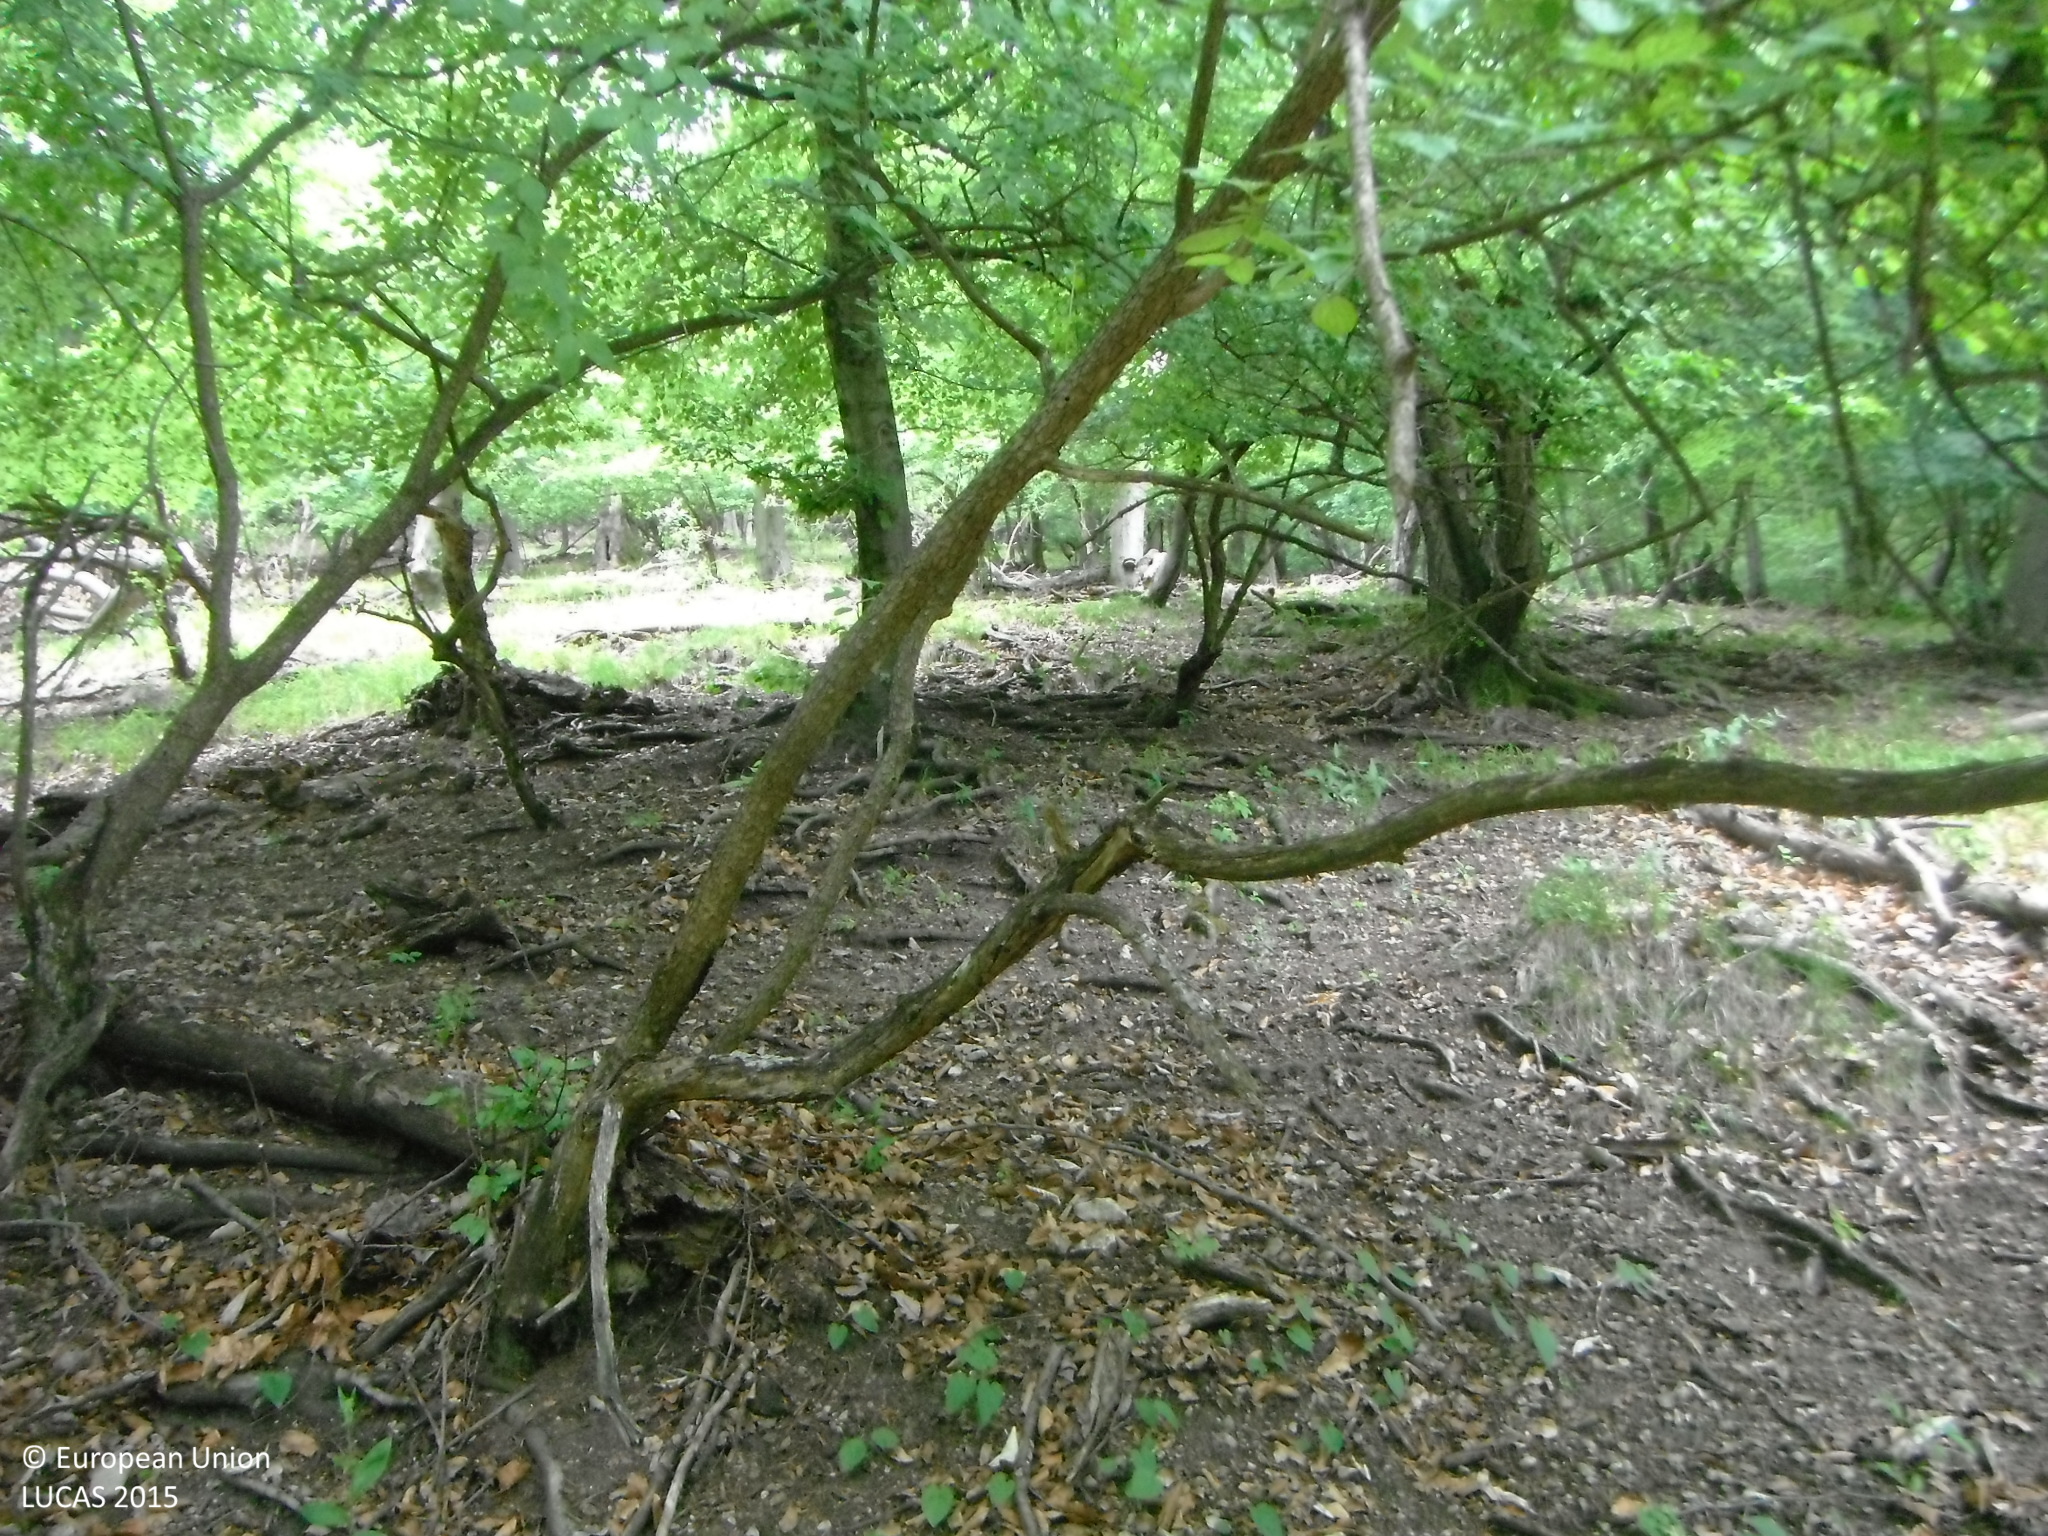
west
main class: Woodland
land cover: Broadleaved woodland
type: beech forest
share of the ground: > 75 %
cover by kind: broadleaved forest trees 80 %, herbaceous plants 15 %, shrubs 5 %
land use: Forestry
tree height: > 5 m
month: June
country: SK
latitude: 48.7541
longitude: 18.3817
